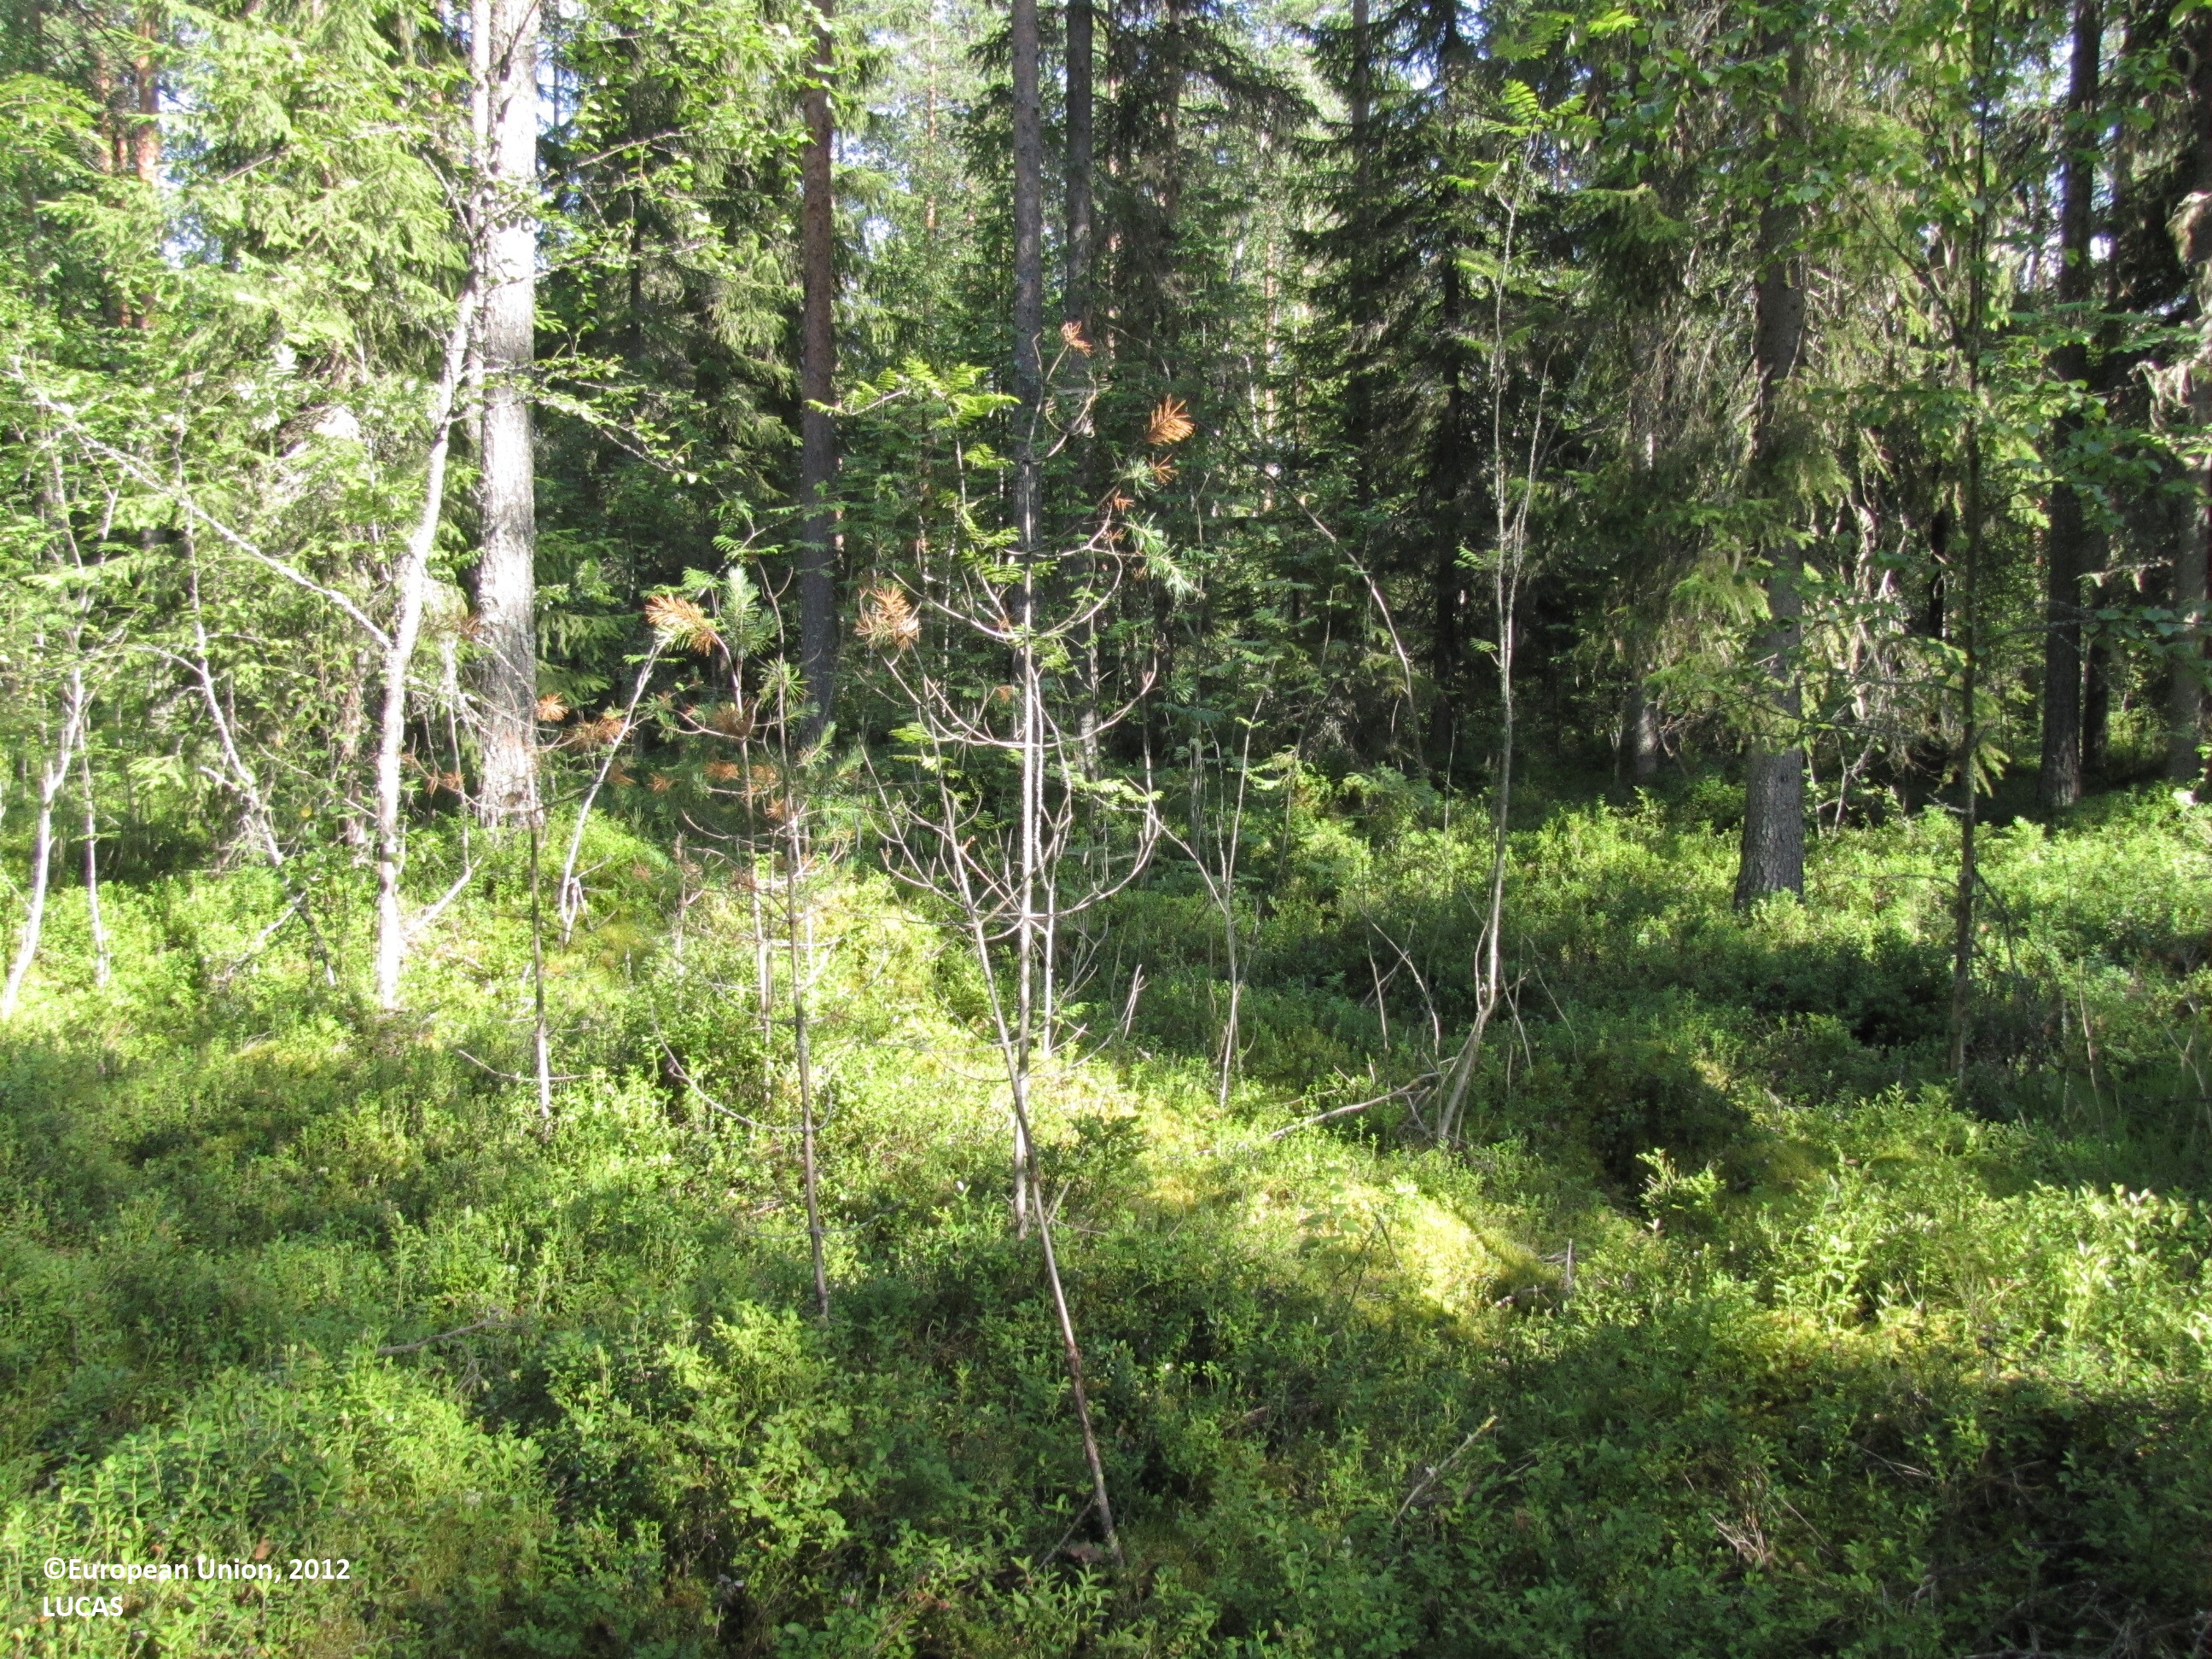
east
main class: Woodland
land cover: Spruce dominated coniferous woodland
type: boreal forest
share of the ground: 50 - 75 %
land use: Forestry
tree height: > 5 m
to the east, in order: Spruce dominated coniferous woodland; Other mixed woodland; Pine dominated mixed woodland; Tracks; Pine dominated coniferous woodland; Tracks; Pine dominated coniferous woodland; Broadleaved woodland
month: July
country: FI
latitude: 62.1868
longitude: 23.2682
